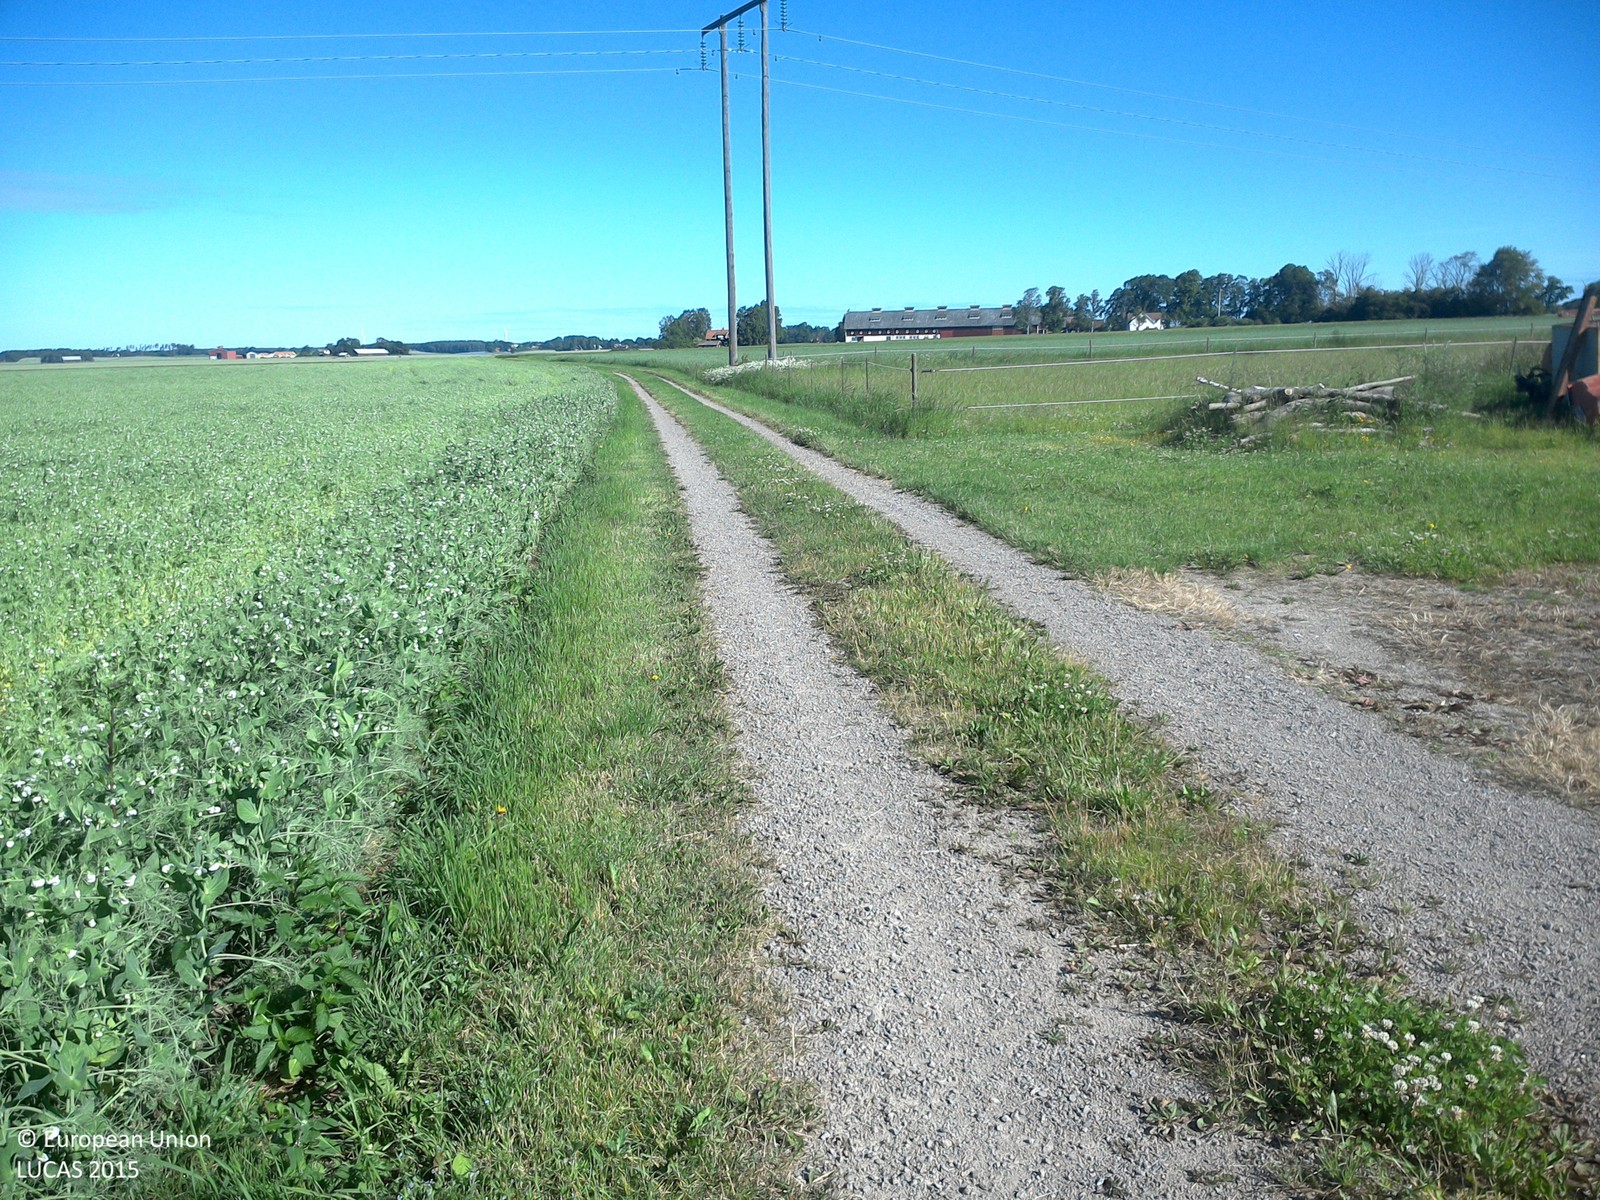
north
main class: Cropland
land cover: Dry pulses
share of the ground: > 75 %
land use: Agriculture (excluding fallow land and kitchen gardens)
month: July
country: SE
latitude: 58.4042
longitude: 15.2820
